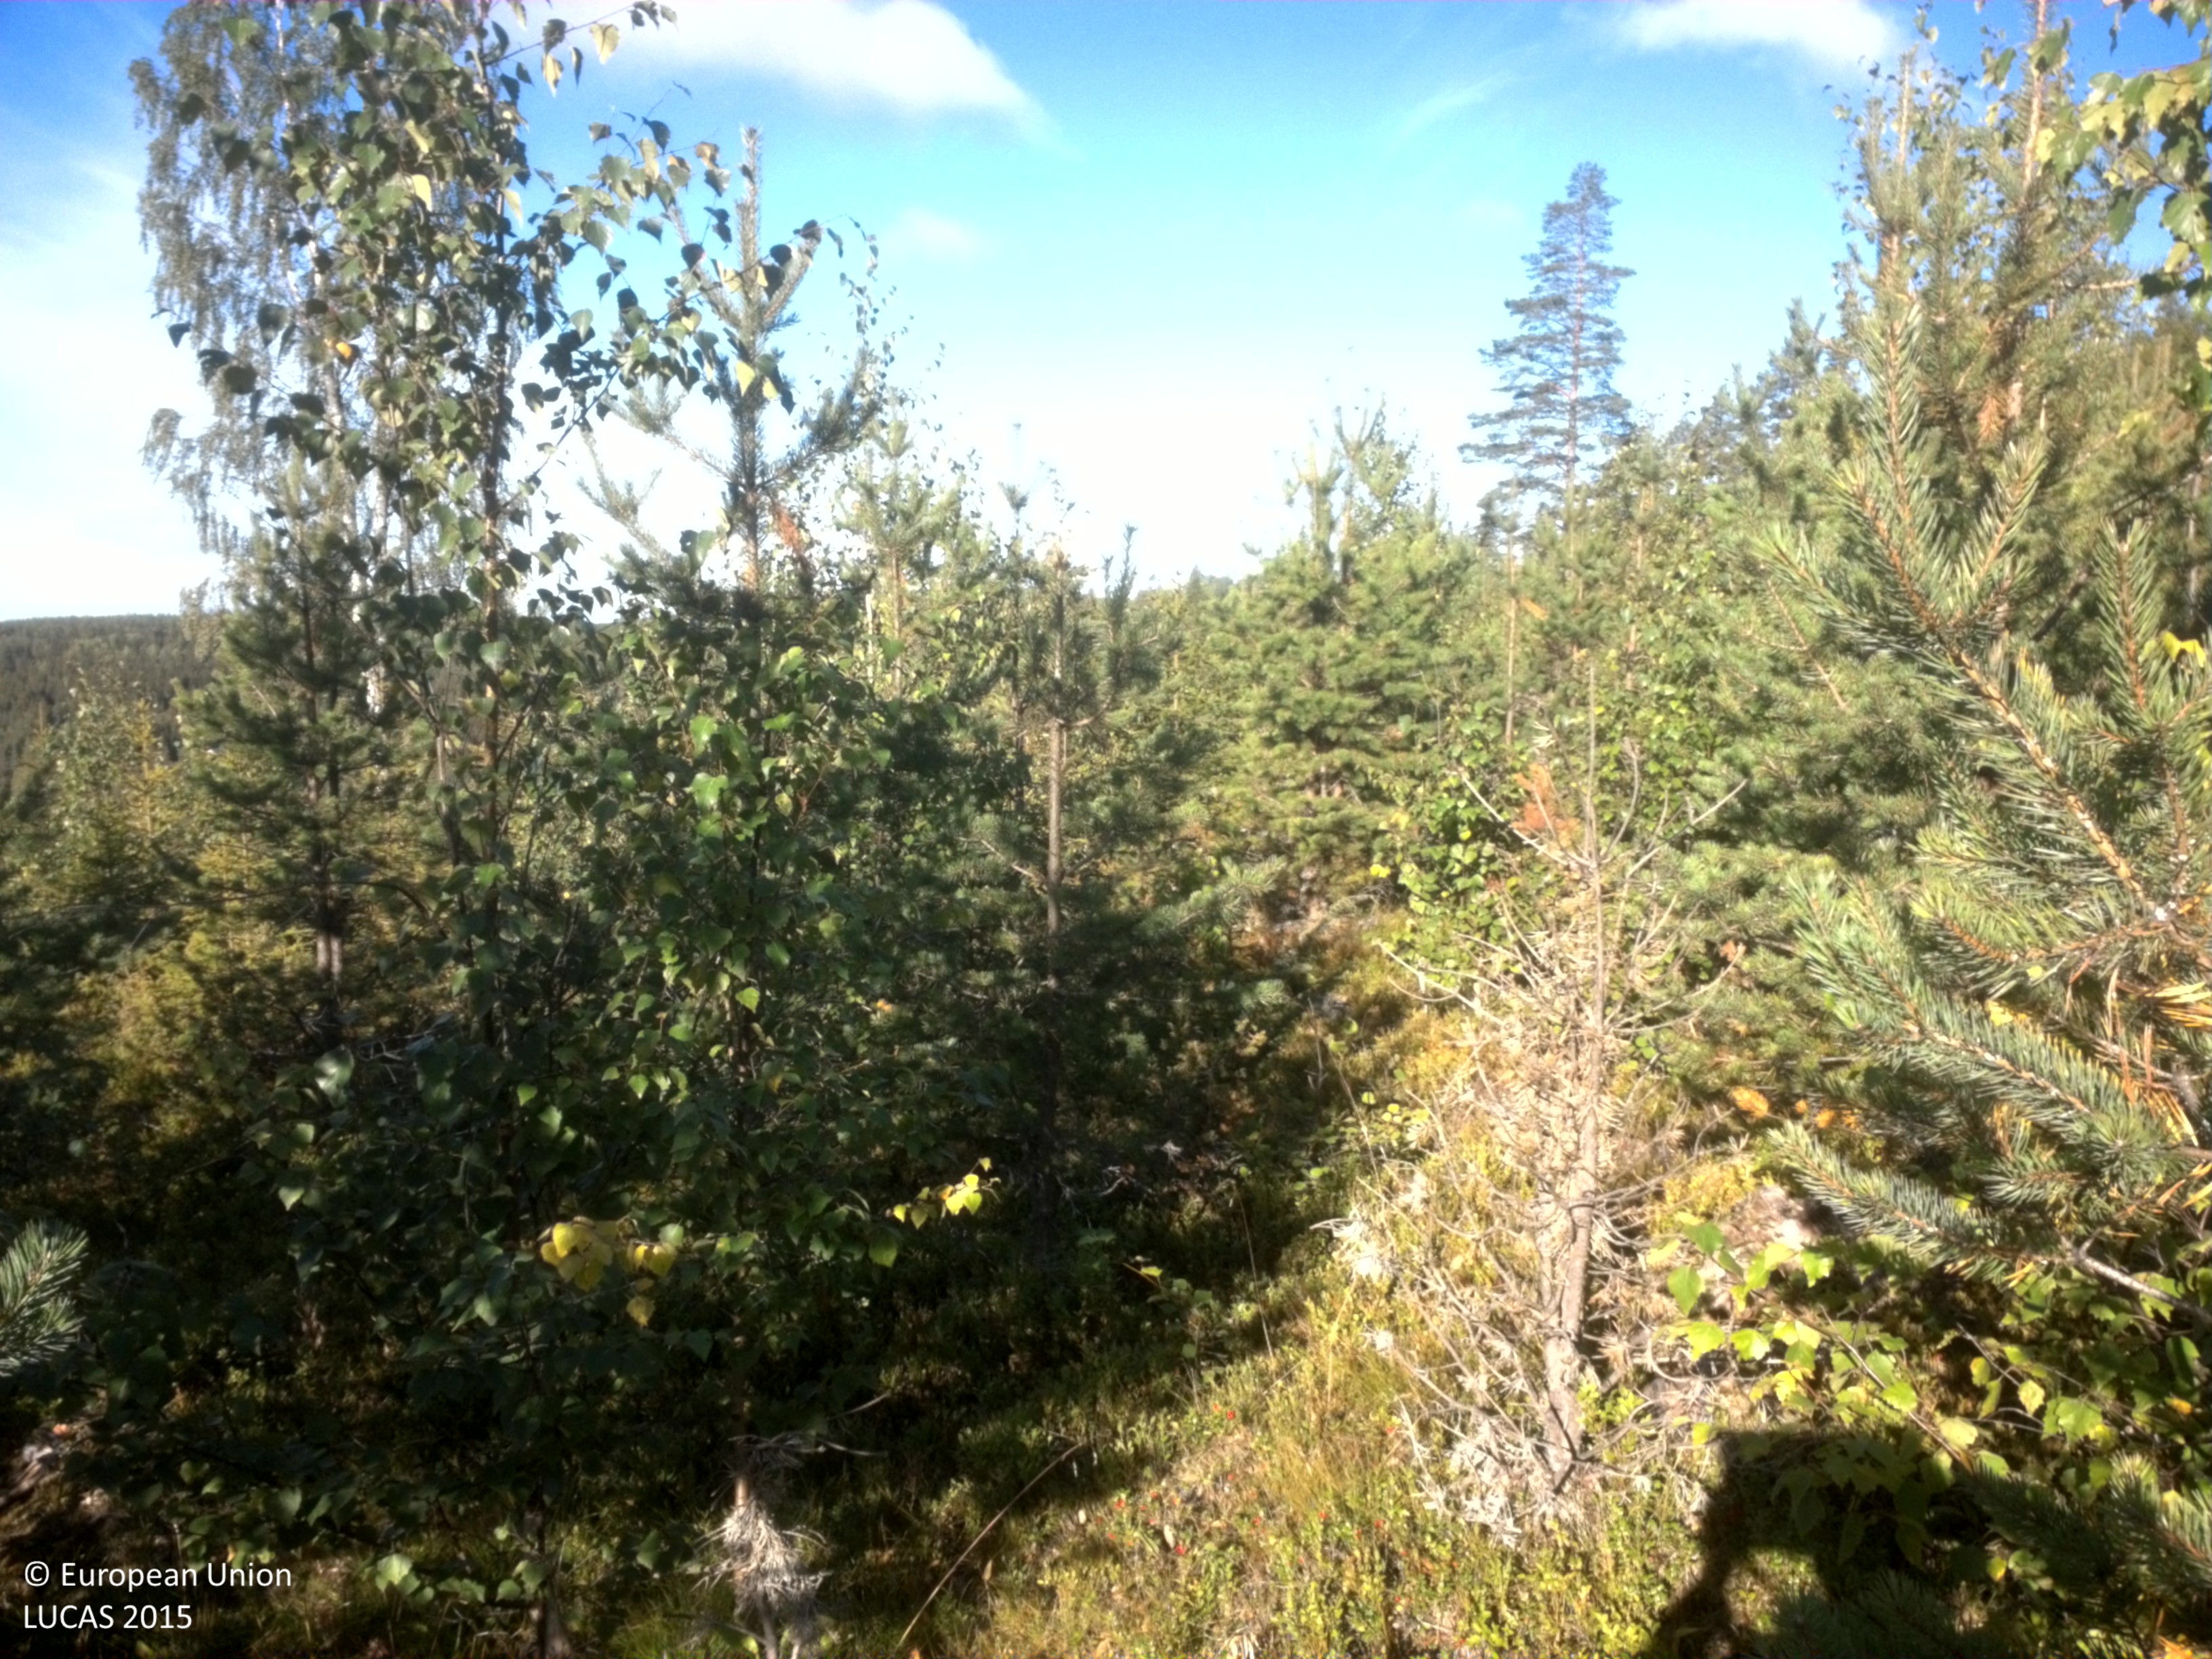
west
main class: Woodland
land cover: Other mixed woodland
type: boreal forest
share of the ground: > 75 %
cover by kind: coniferous forest trees 45 %, broadleaved forest trees 35 %, shrubs 10 %, herbaceous plants 5 %, lichens and mosses 5 %
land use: Forestry
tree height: < 5 m
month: September
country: SE
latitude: 64.5917
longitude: 19.0975
